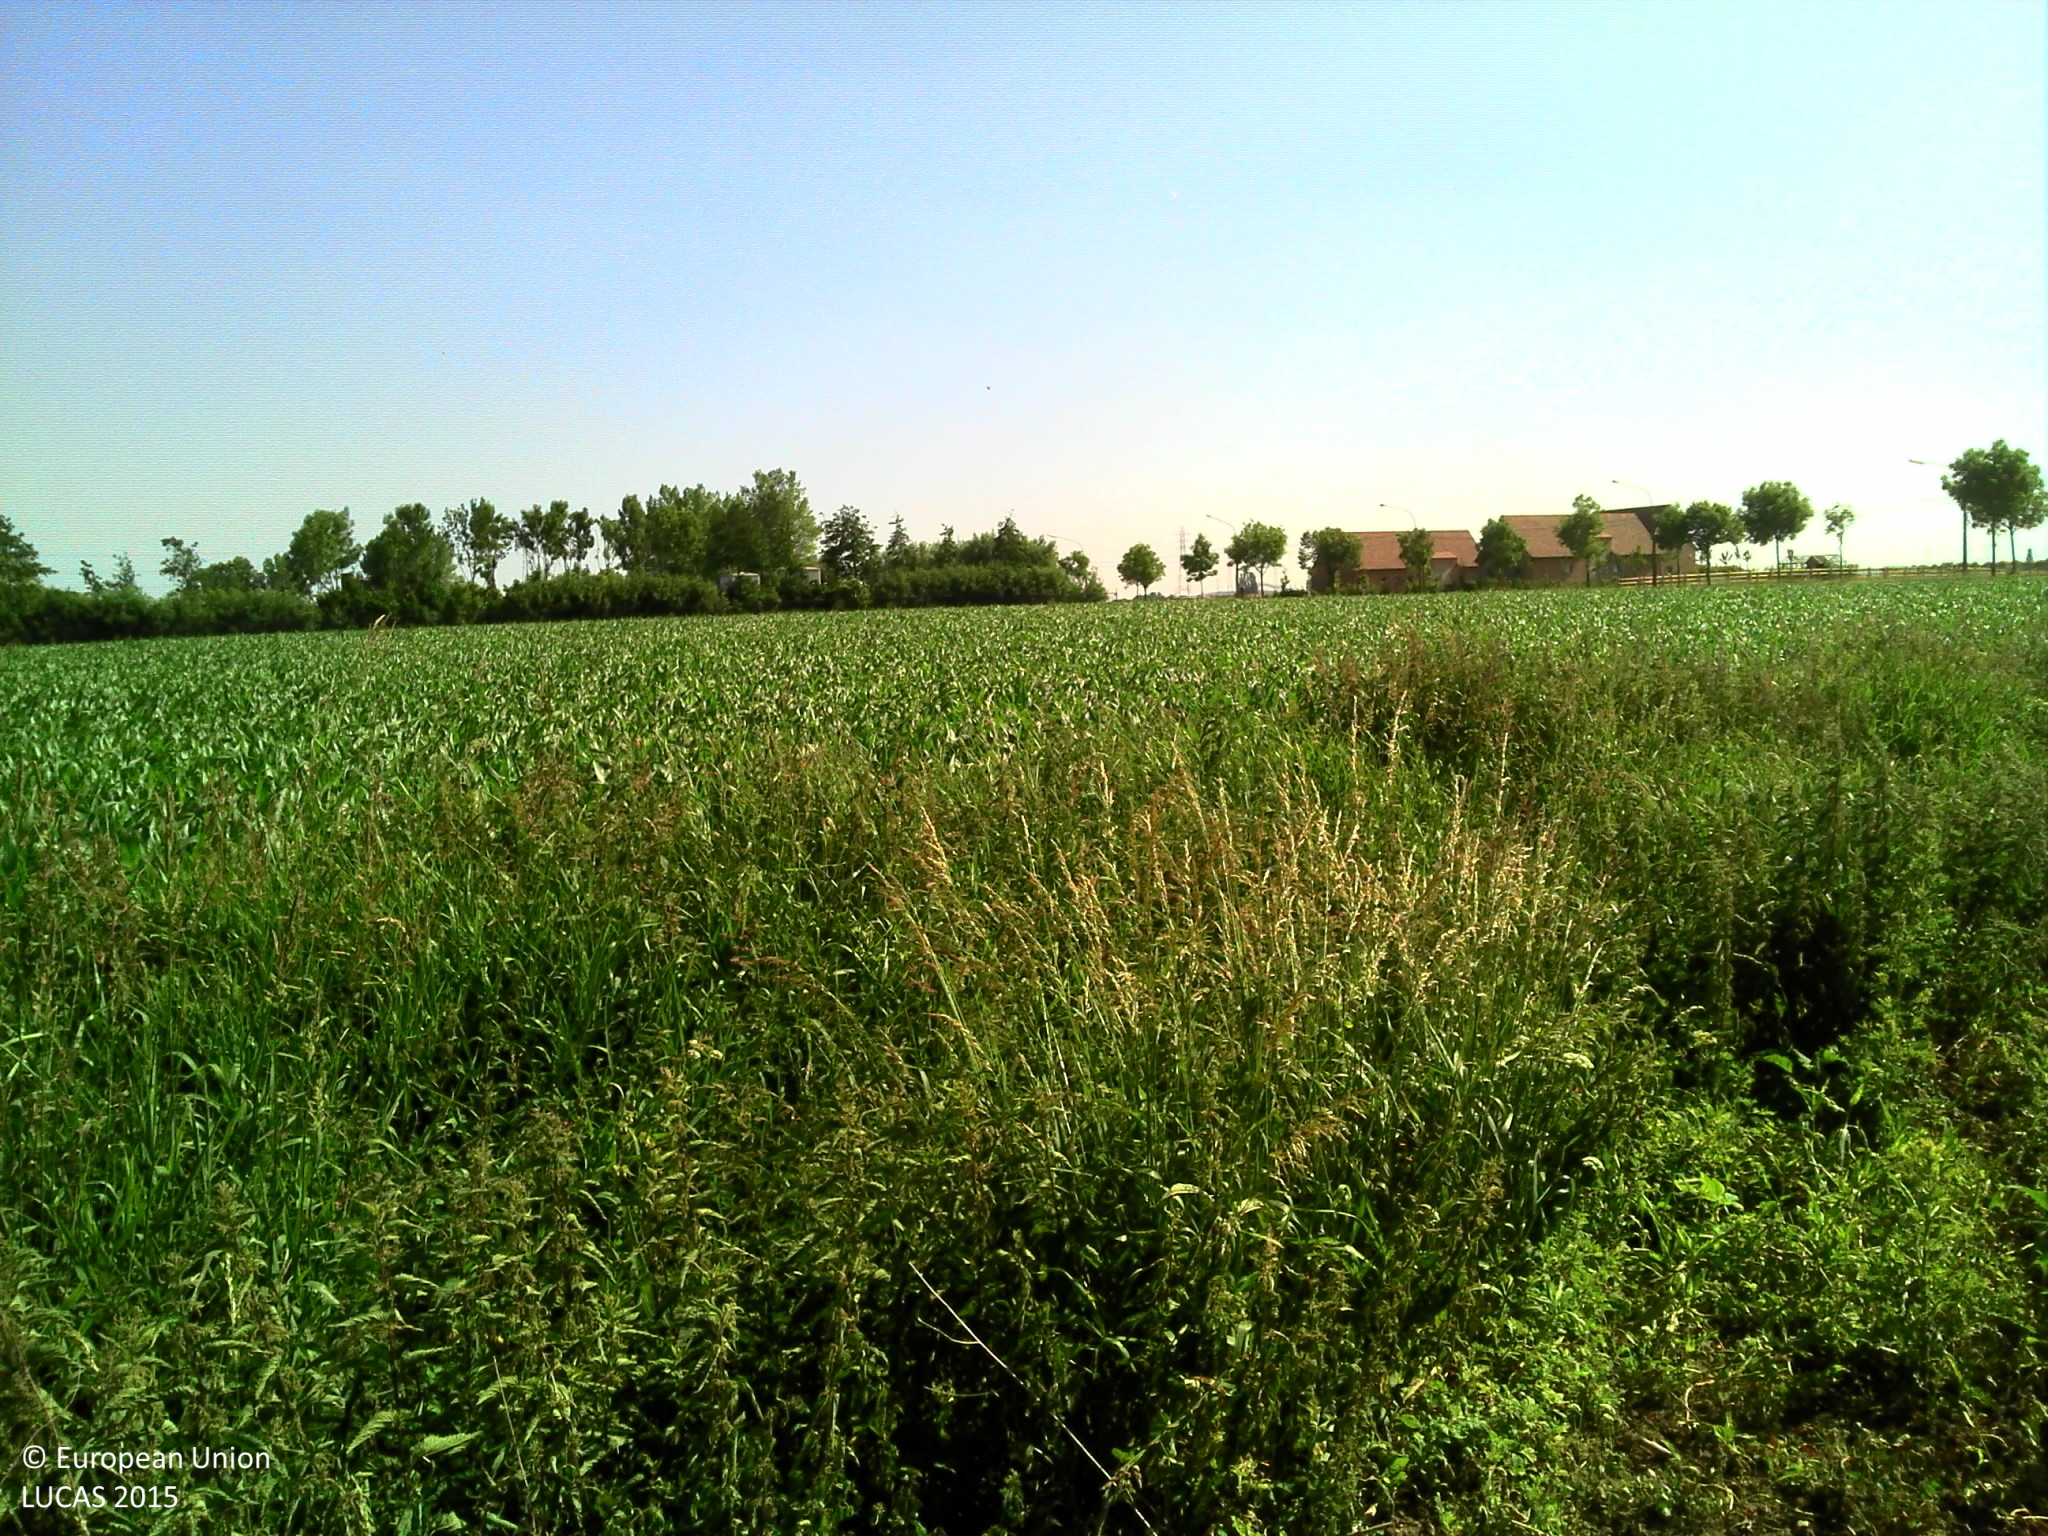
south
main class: Cropland
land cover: Maize
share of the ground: 50 - 75 %
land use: Agriculture (excluding fallow land and kitchen gardens)
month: June
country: BE
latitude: 50.8815
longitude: 2.8683
